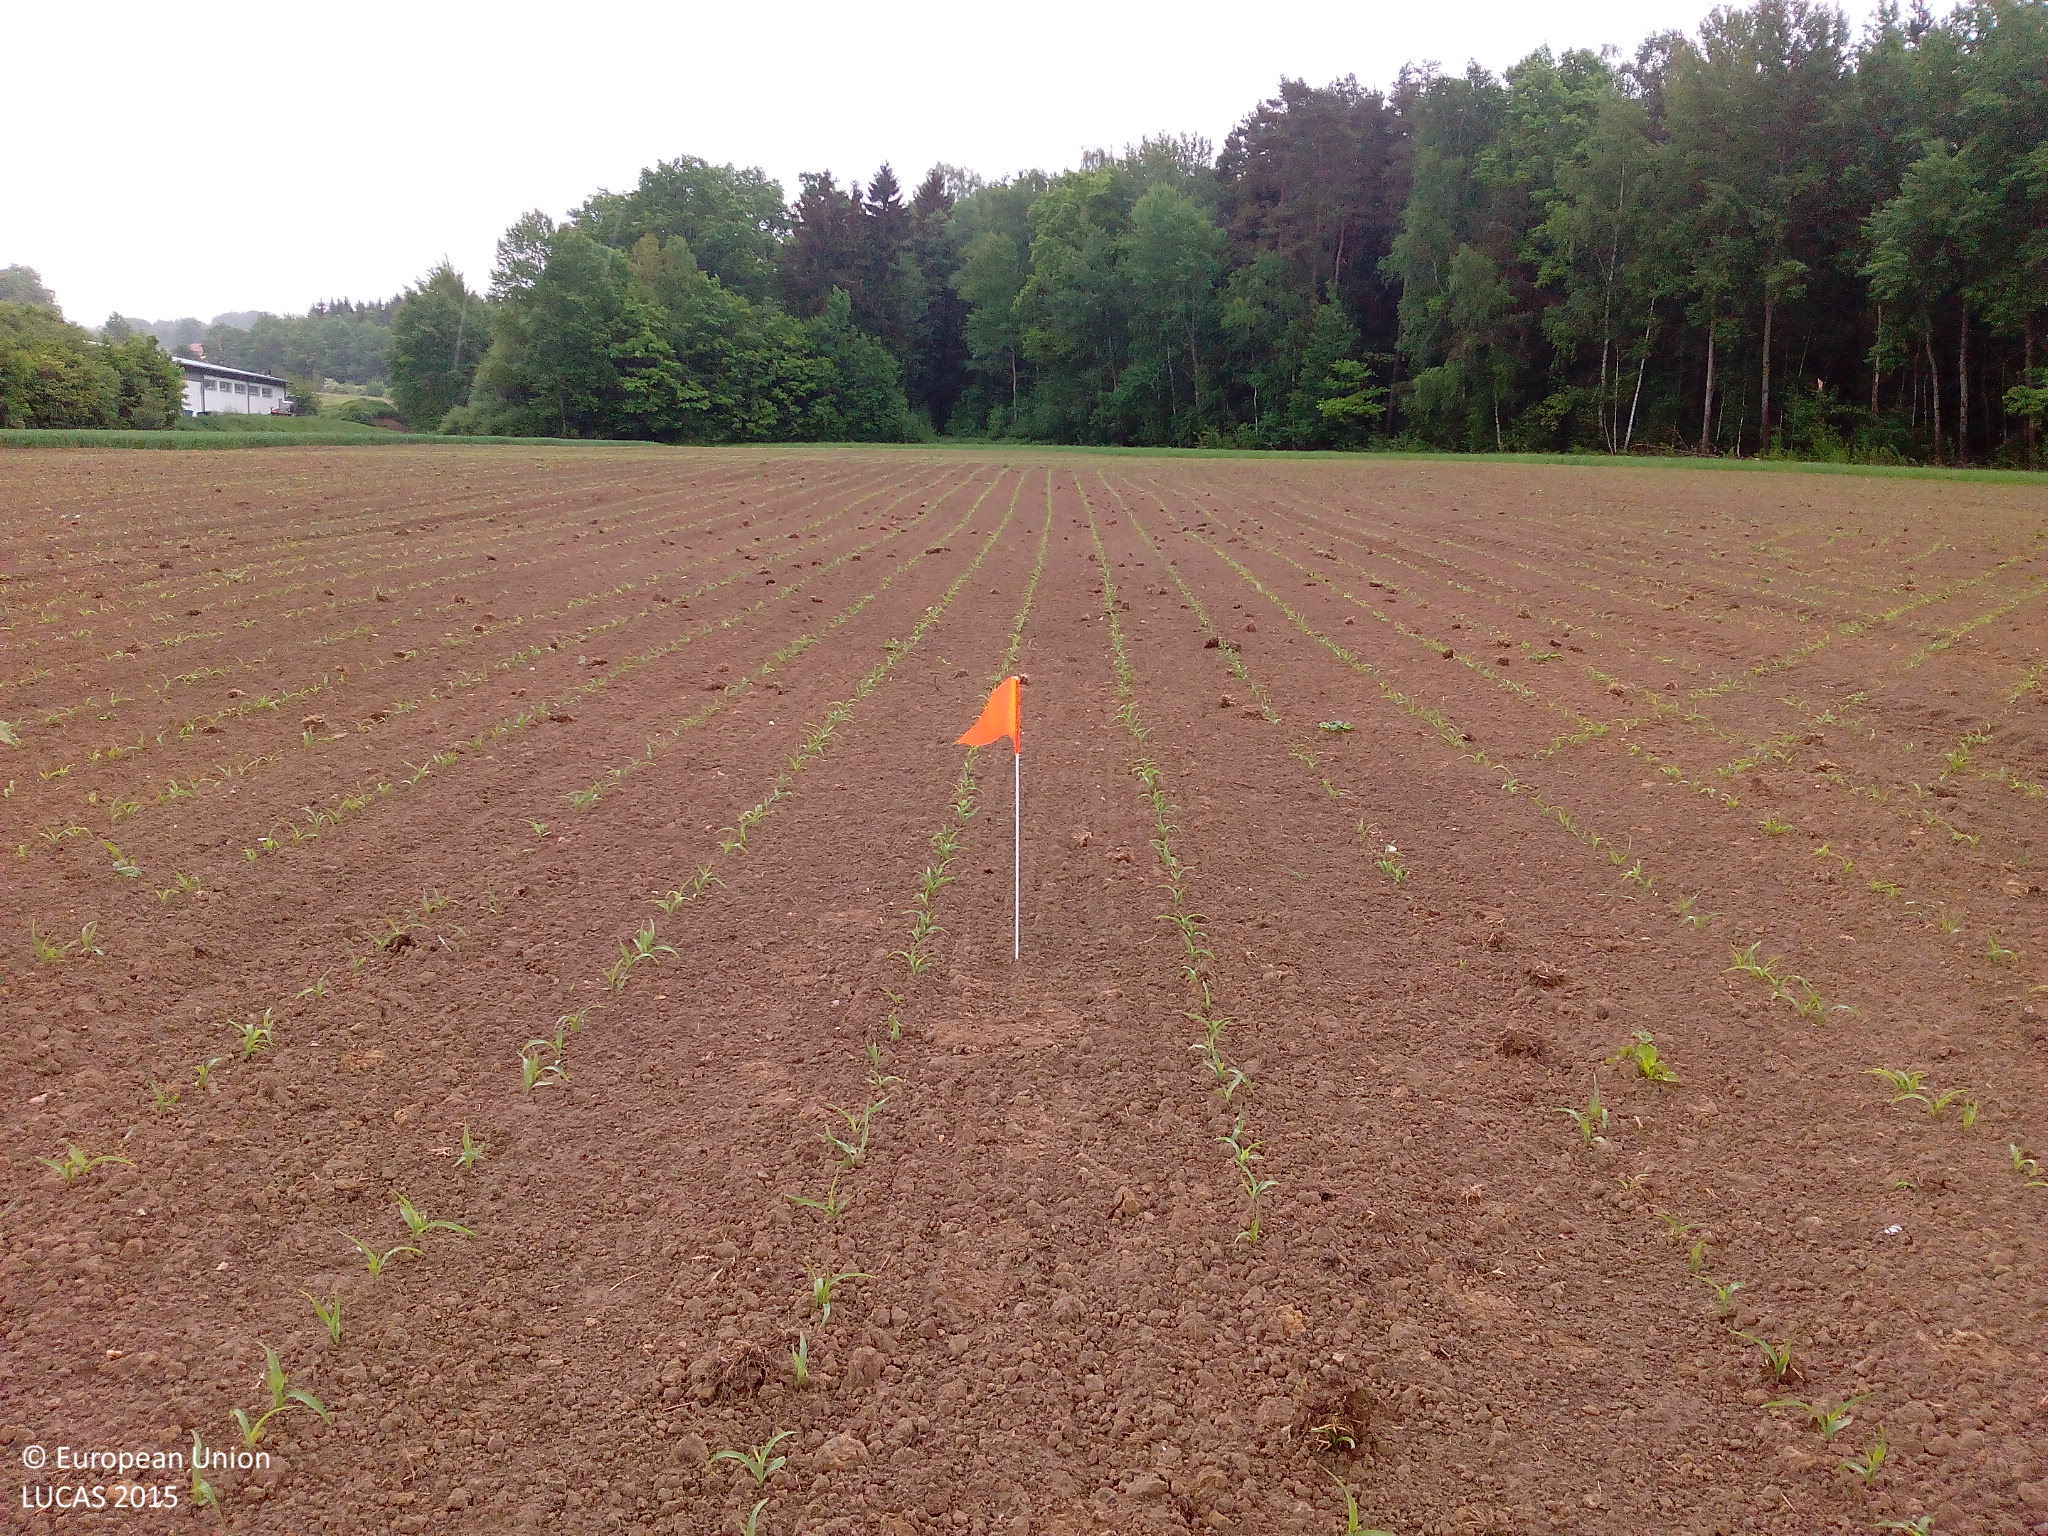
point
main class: Cropland
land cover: Maize
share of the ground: < 10 %
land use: Agriculture (excluding fallow land and kitchen gardens)
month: May
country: DE
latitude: 49.3113
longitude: 11.4713
